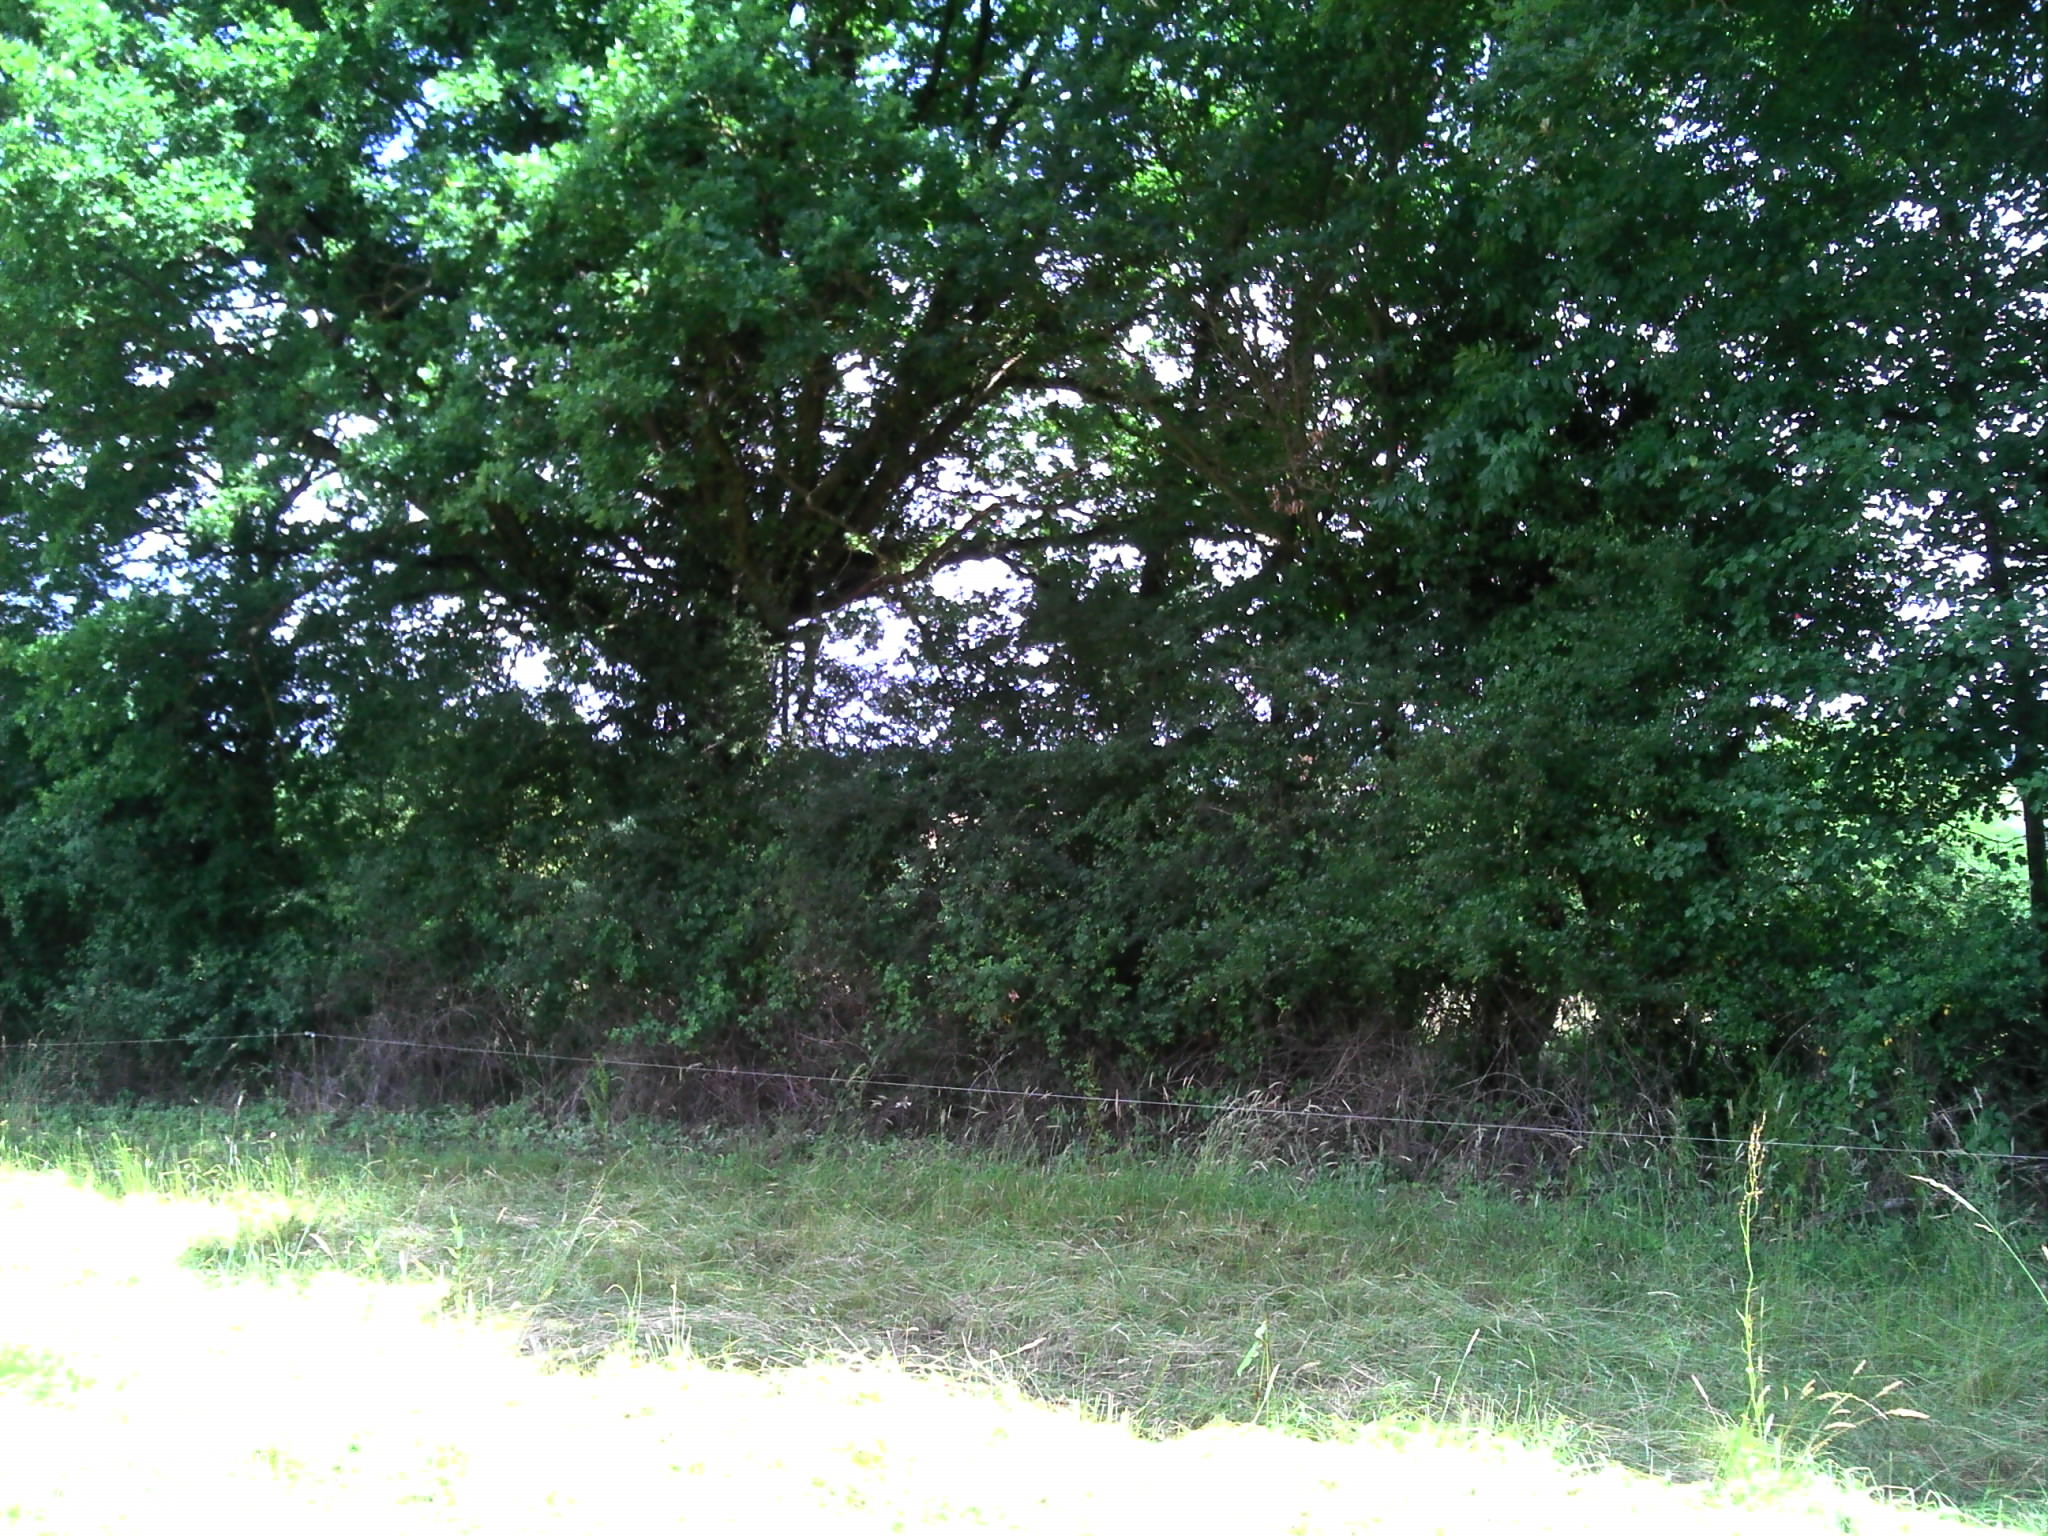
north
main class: Grassland
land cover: Grassland without tree/shrub cover
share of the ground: > 75 %
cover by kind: herbaceous plants 100 %
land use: Agriculture (excluding fallow land and kitchen gardens)
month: June
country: FR
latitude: 46.5164
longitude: 2.6836
